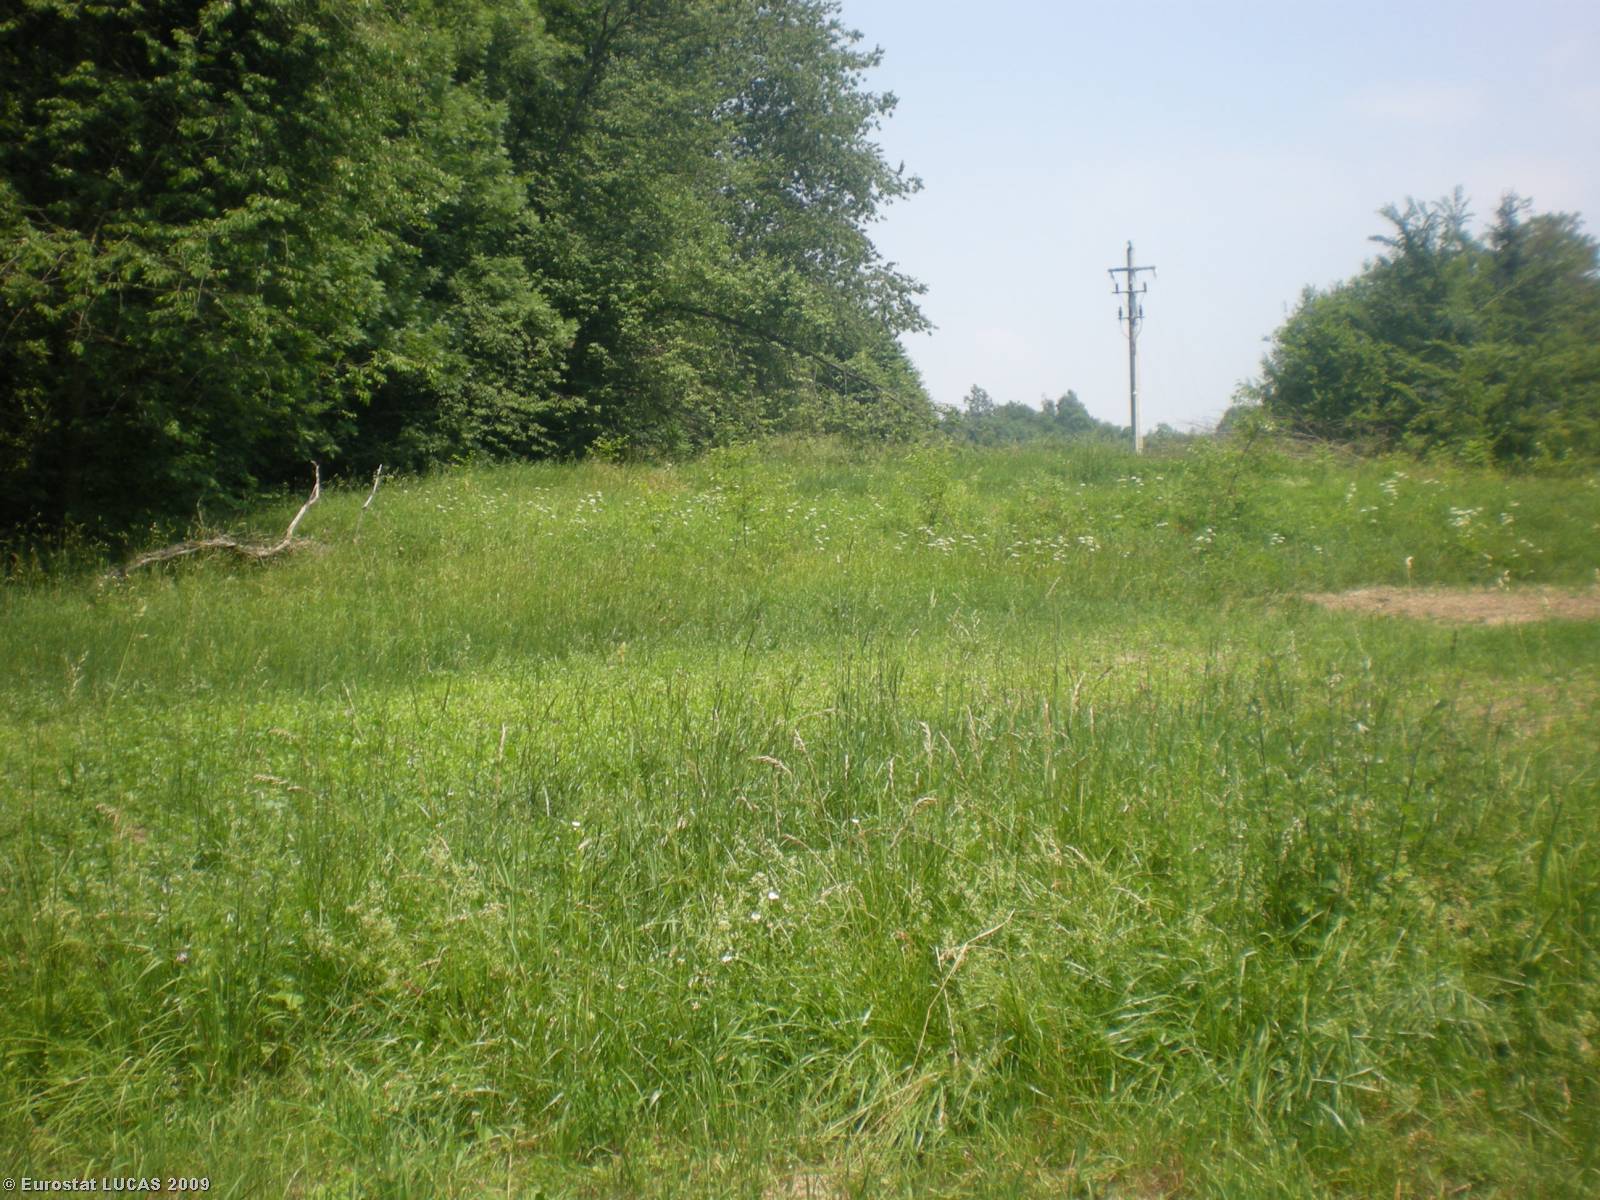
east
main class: Grassland
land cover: Grassland without tree/shrub cover
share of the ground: > 75 %
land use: Agriculture (excluding fallow land and kitchen gardens)
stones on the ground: < 10 %
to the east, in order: Grassland without tree/shrub cover; Fences; Spontaneously vegetated surfaces; Grassland with sparse tree/shrub cover; Spontaneously vegetated surfaces; Groves; Spontaneously vegetated surfaces; Broadleaved woodland; Shrubland without tree cover; Broadleaved woodland
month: June
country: IT
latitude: 44.3357
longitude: 7.3843
